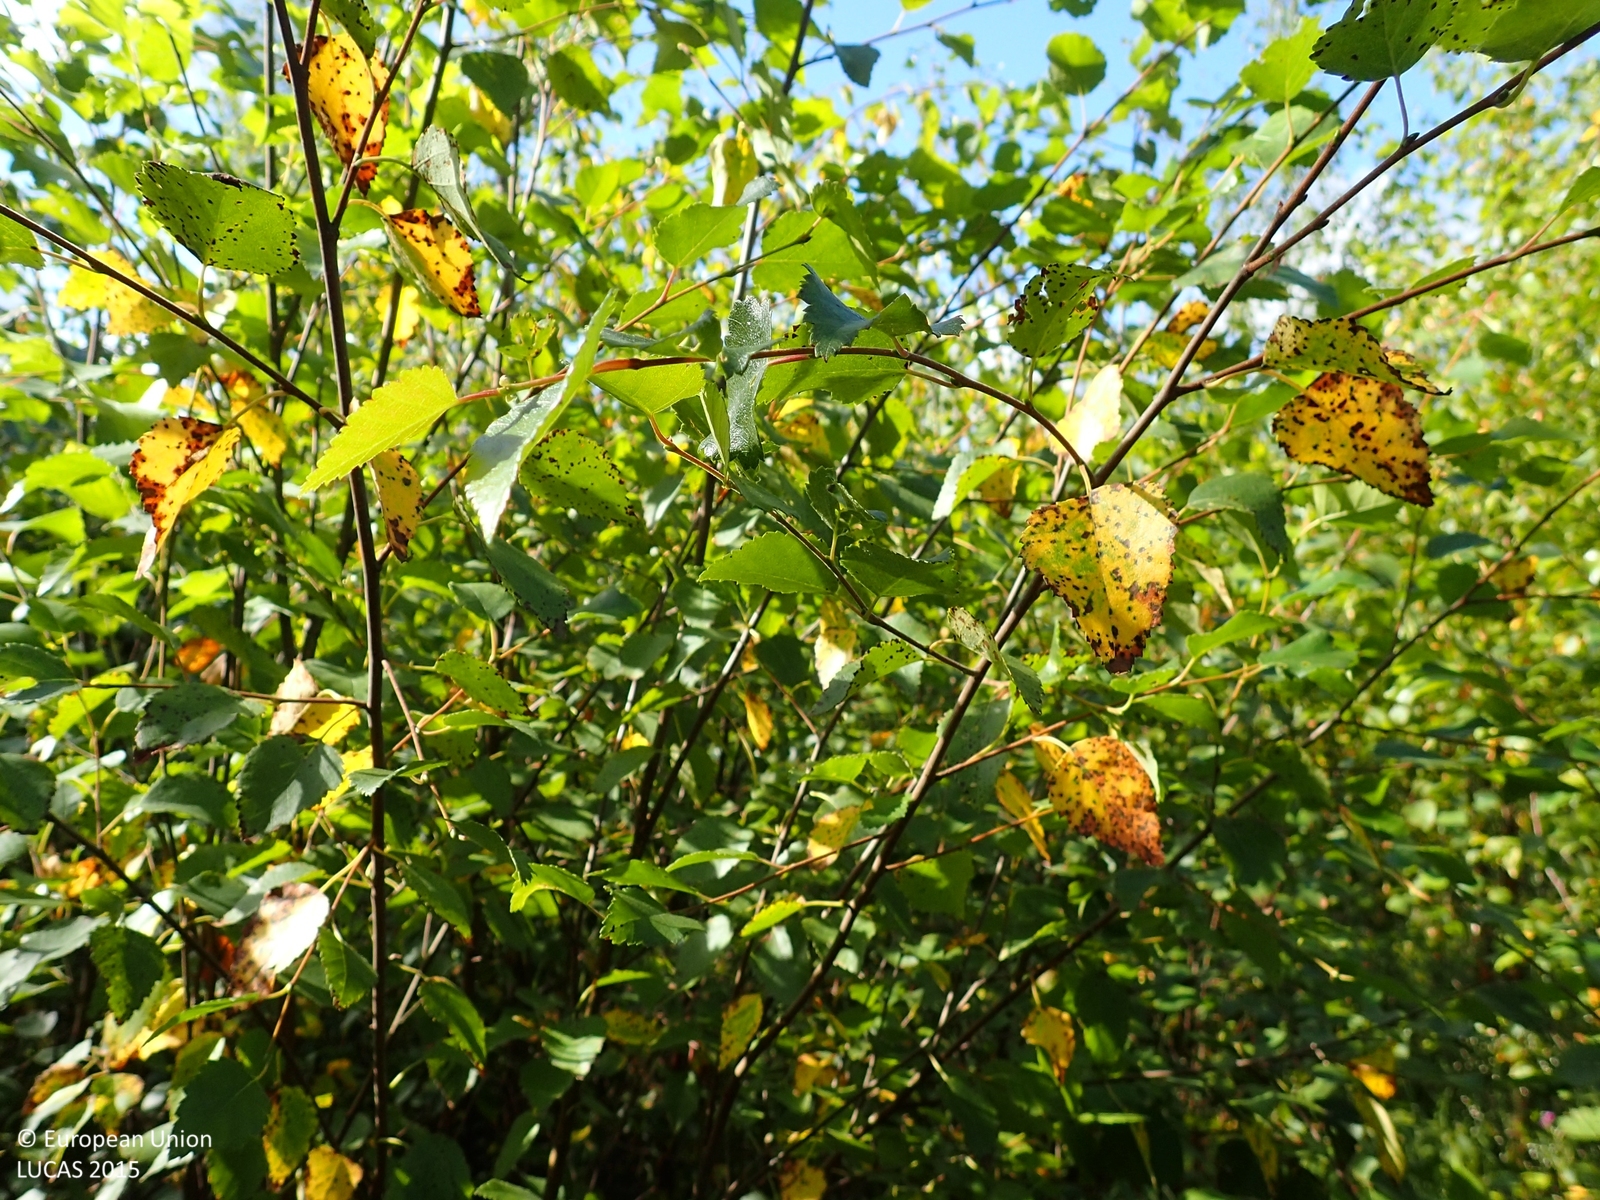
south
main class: Woodland
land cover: Broadleaved woodland
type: non-riverine alder, birch or aspen forest
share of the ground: > 75 %
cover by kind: broadleaved forest trees 90 %, herbaceous plants 10 %
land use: Forestry
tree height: < 5 m
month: August
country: FI
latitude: 62.7159
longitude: 21.9949
